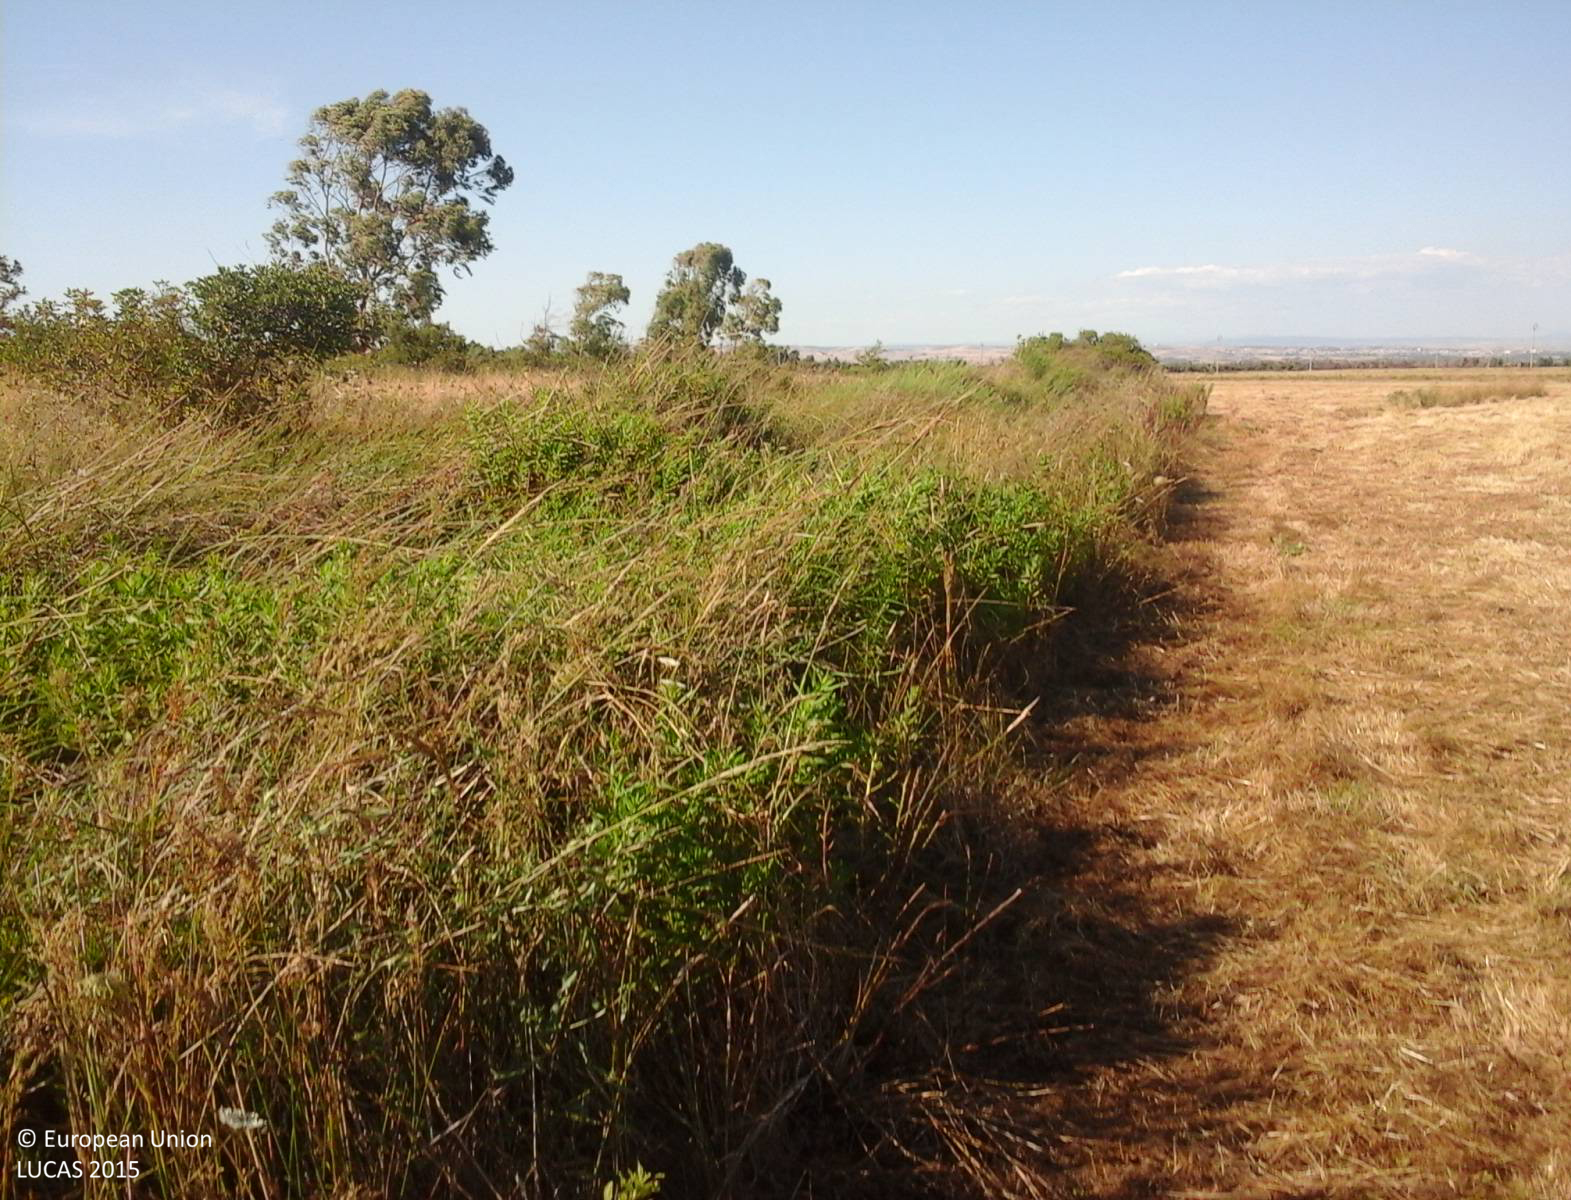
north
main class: Grassland
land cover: Grassland without tree/shrub cover
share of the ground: > 75 %
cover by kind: herbaceous plants 100 %
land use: Semi-natural and natural areas not in use
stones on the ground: 25 - 50 %
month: June
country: IT
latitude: 39.4810
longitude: 8.7865
